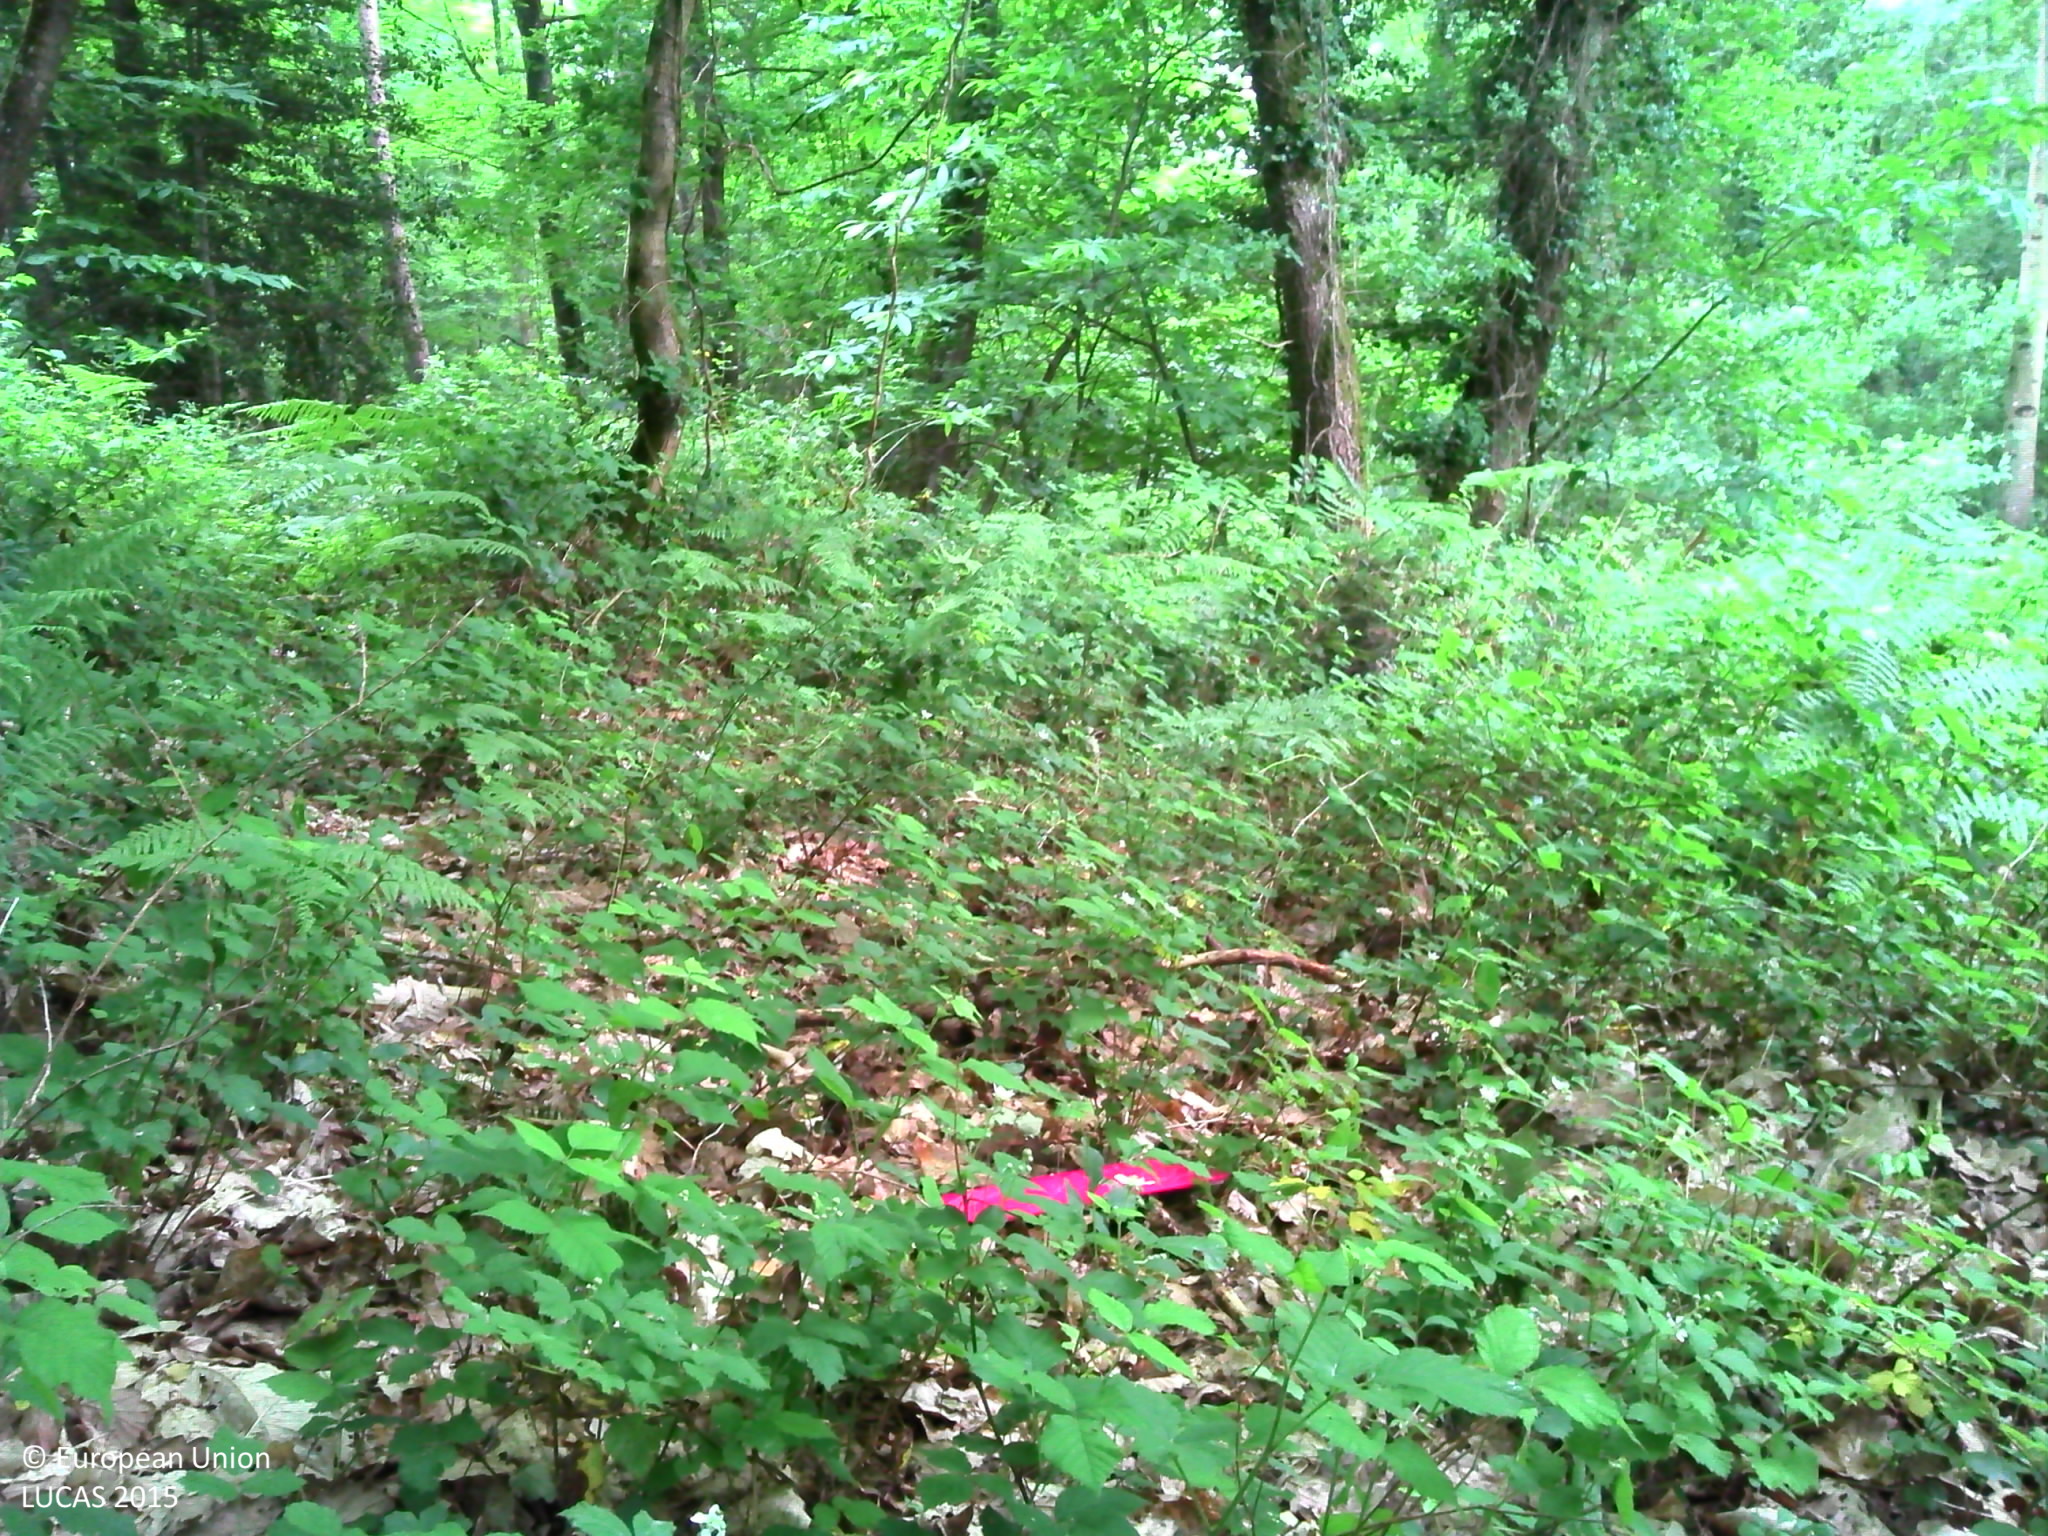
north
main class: Woodland
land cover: Broadleaved woodland
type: mesophytic deciduous forest
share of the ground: > 75 %
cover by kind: broadleaved forest trees 75 %, herbaceous plants 10 %, coniferous forest trees 5 %, shrubs 5 %, lichens and mosses 5 %
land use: Forestry
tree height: > 5 m
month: June
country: FR
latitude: 48.1147
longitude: -1.9665
